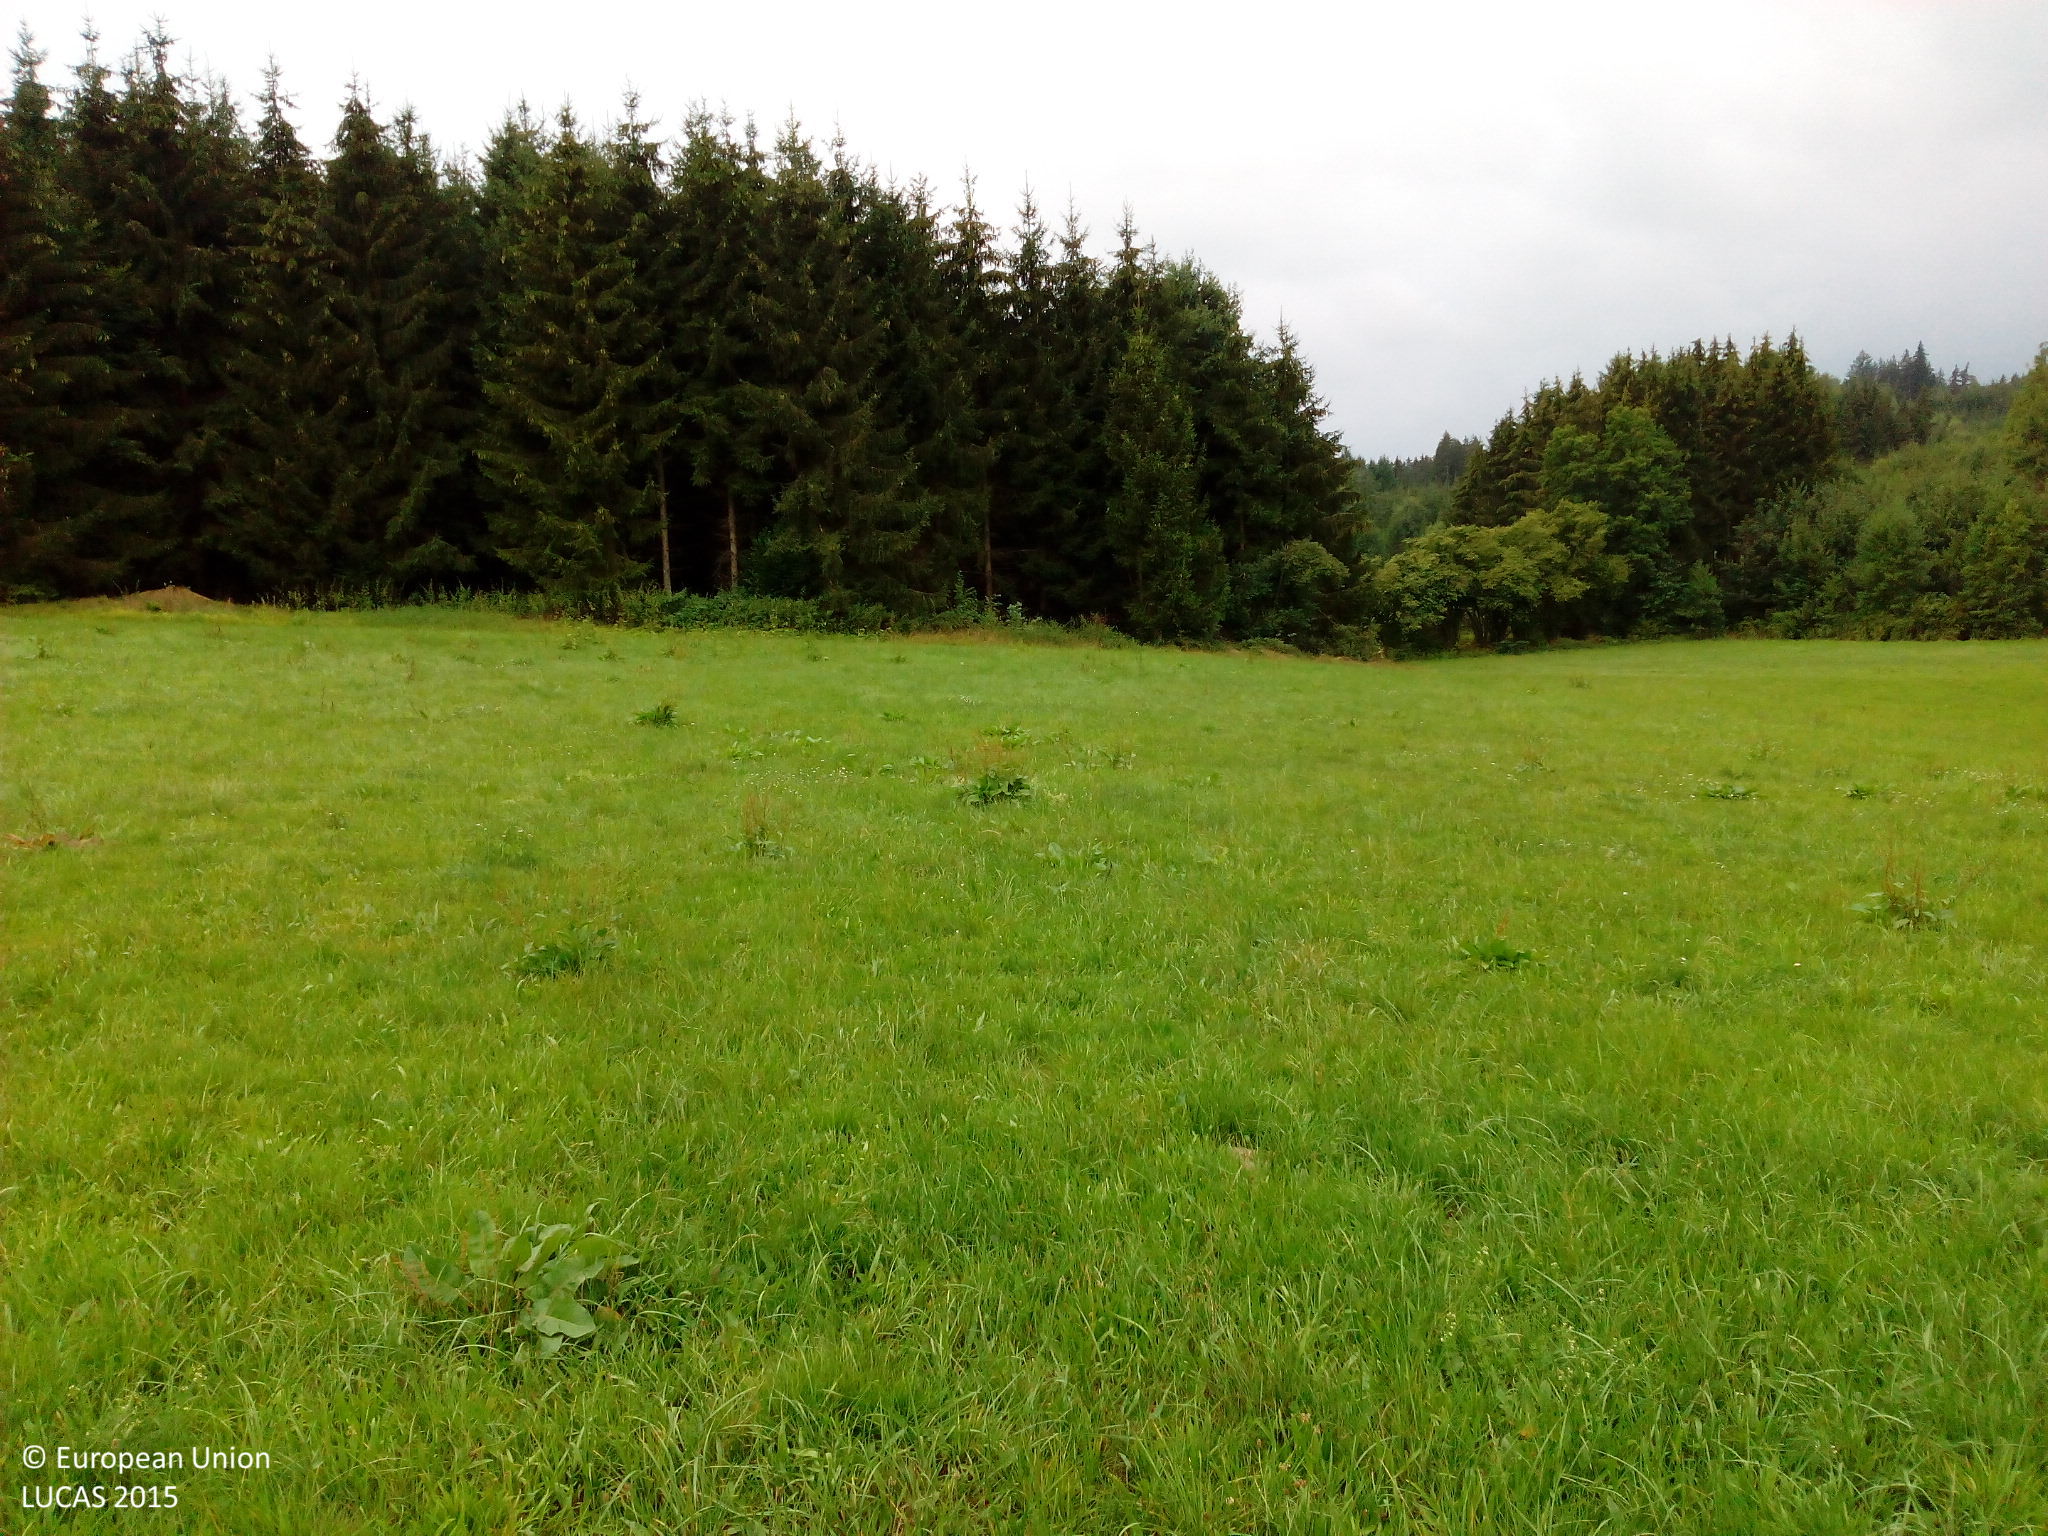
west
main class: Grassland
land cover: Grassland without tree/shrub cover
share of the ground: > 75 %
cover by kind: herbaceous plants 100 %
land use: Agriculture (excluding fallow land and kitchen gardens)
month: September
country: DE
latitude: 48.3482
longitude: 10.5259
